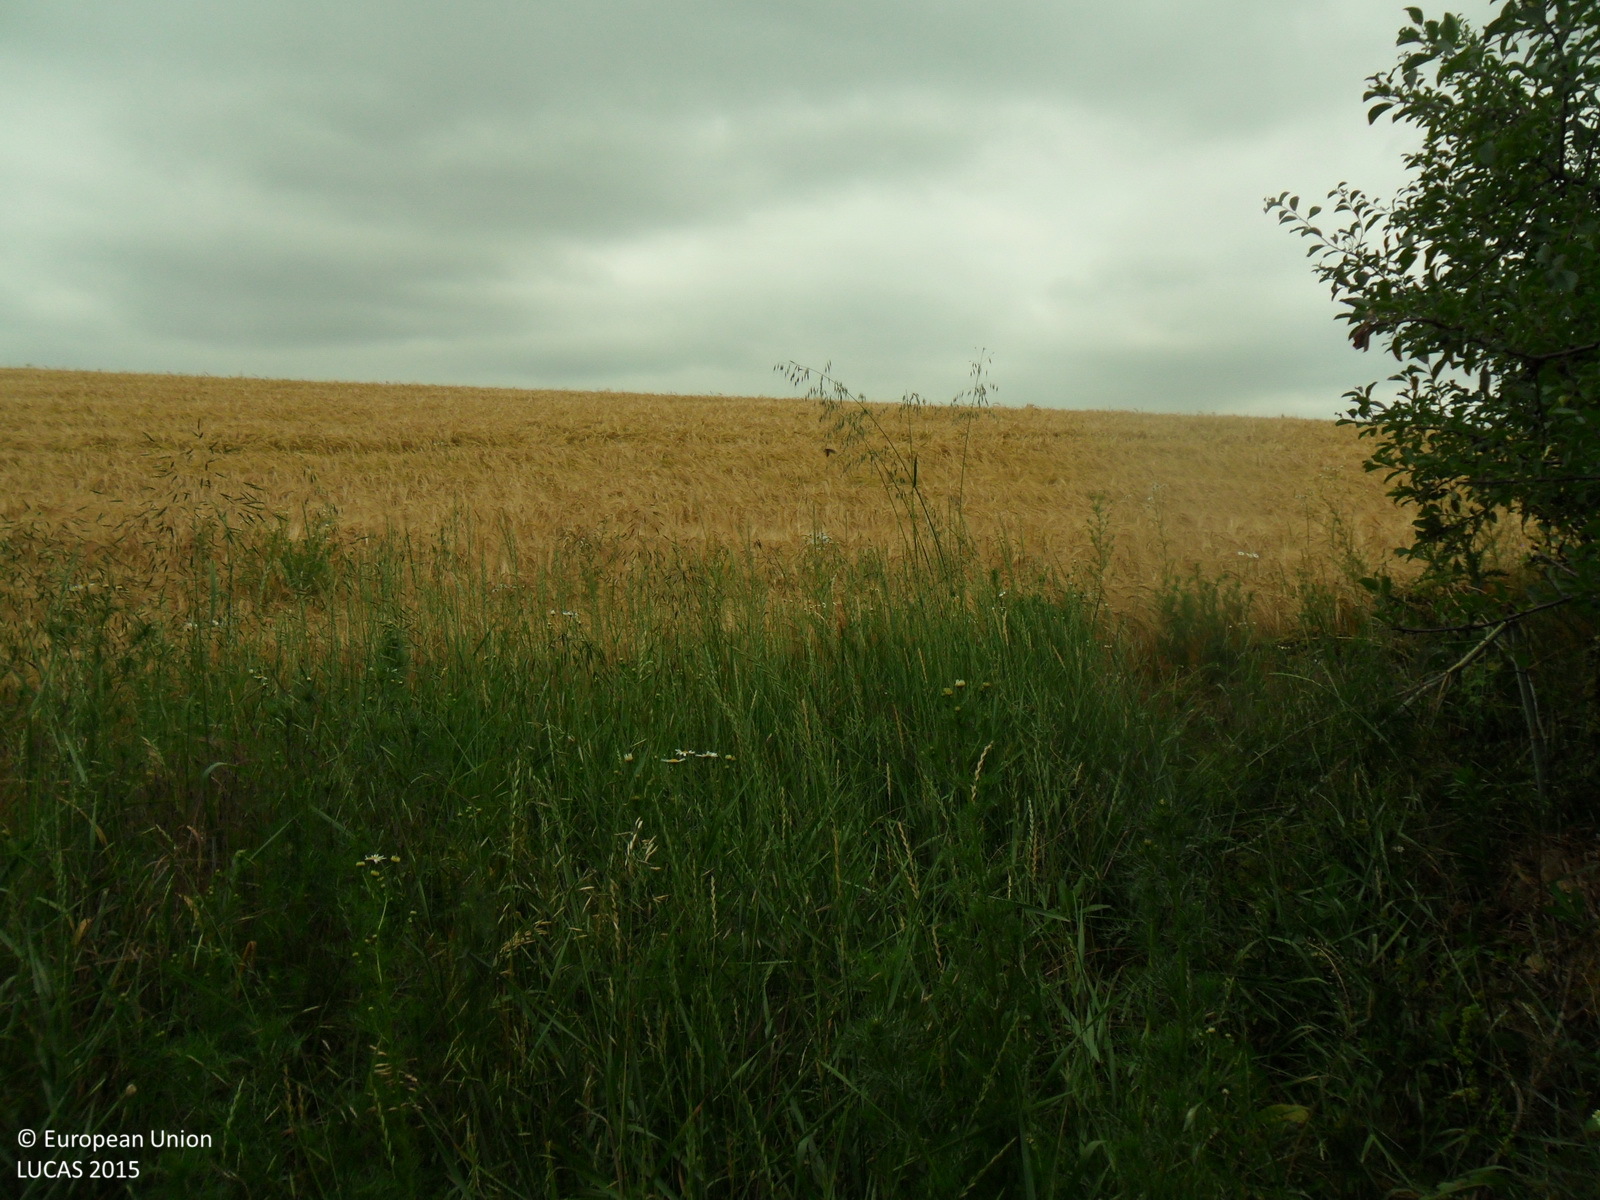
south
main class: Cropland
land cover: Other fruit trees and berries
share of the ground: > 75 %
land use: Agriculture (excluding fallow land and kitchen gardens)
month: June
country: BG
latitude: 43.7078
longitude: 26.7809
